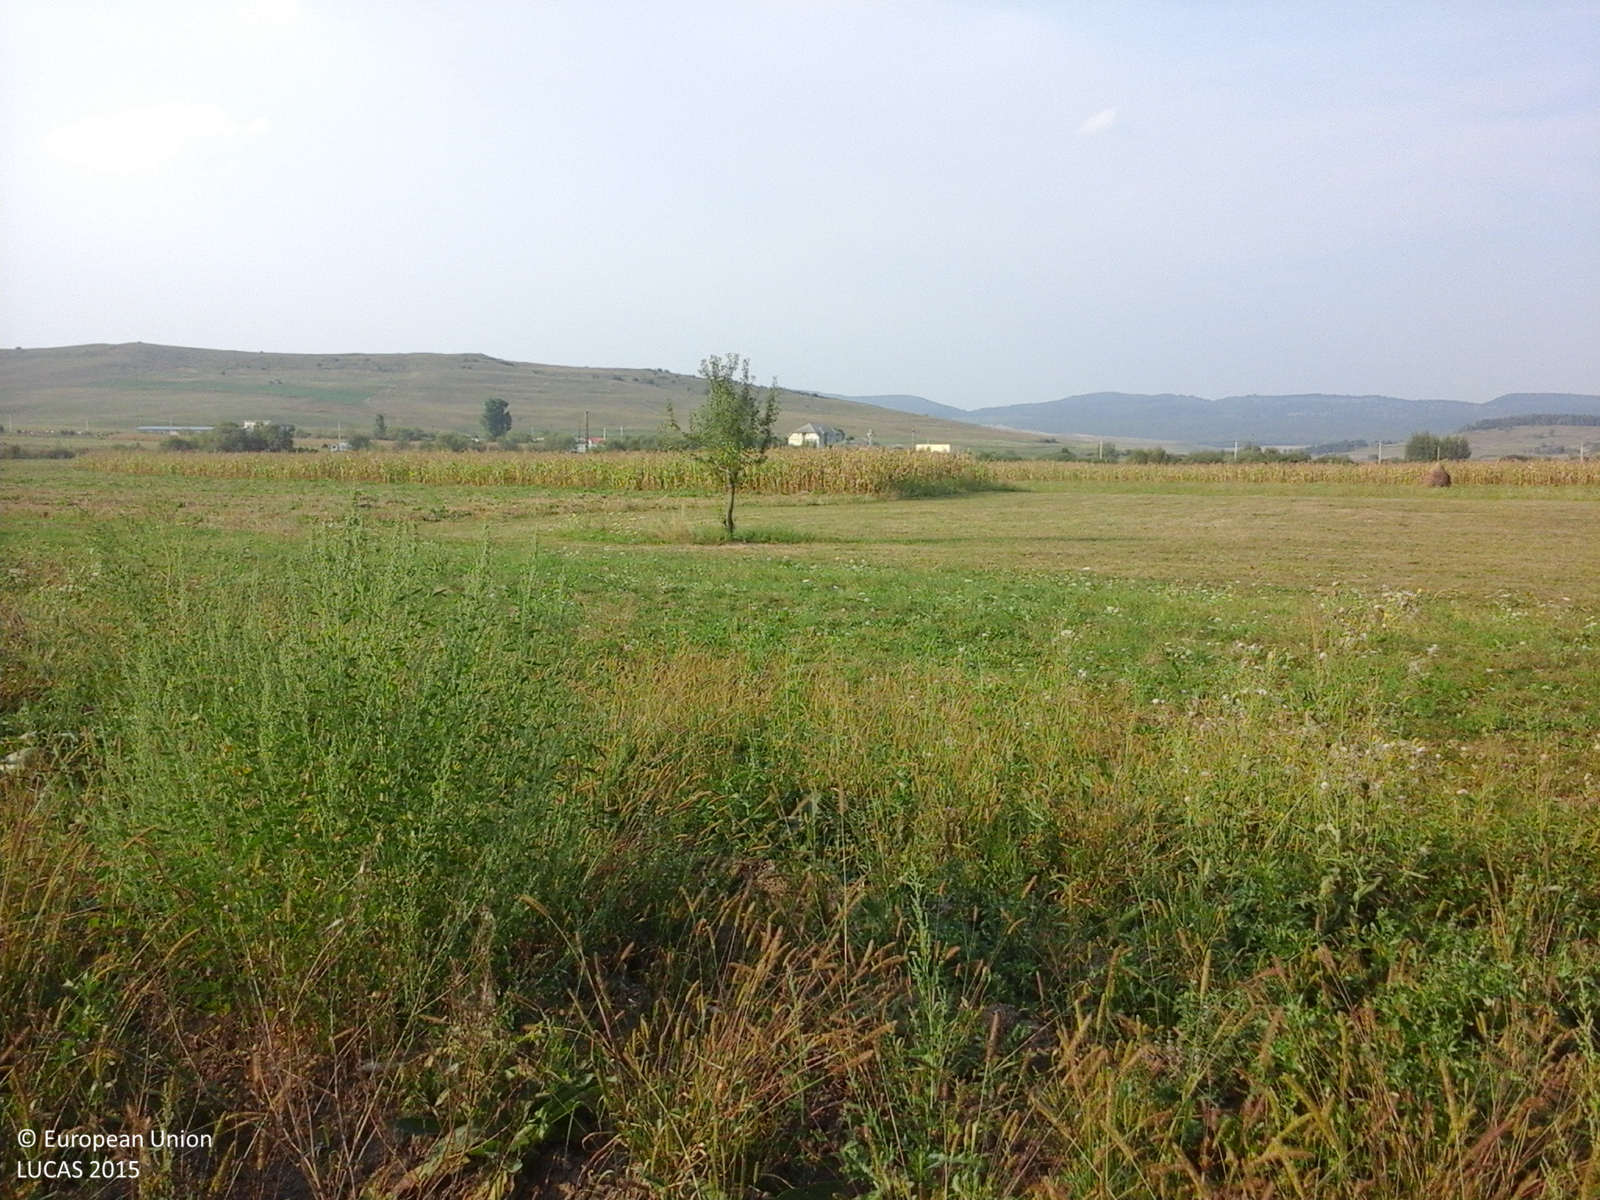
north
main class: Cropland
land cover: Potatoes
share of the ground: 10 - 25 %
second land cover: Spontaneously vegetated surfaces
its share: > 75 %
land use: Agriculture (excluding fallow land and kitchen gardens)
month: September
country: RO
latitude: 47.2007
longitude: 24.3853
